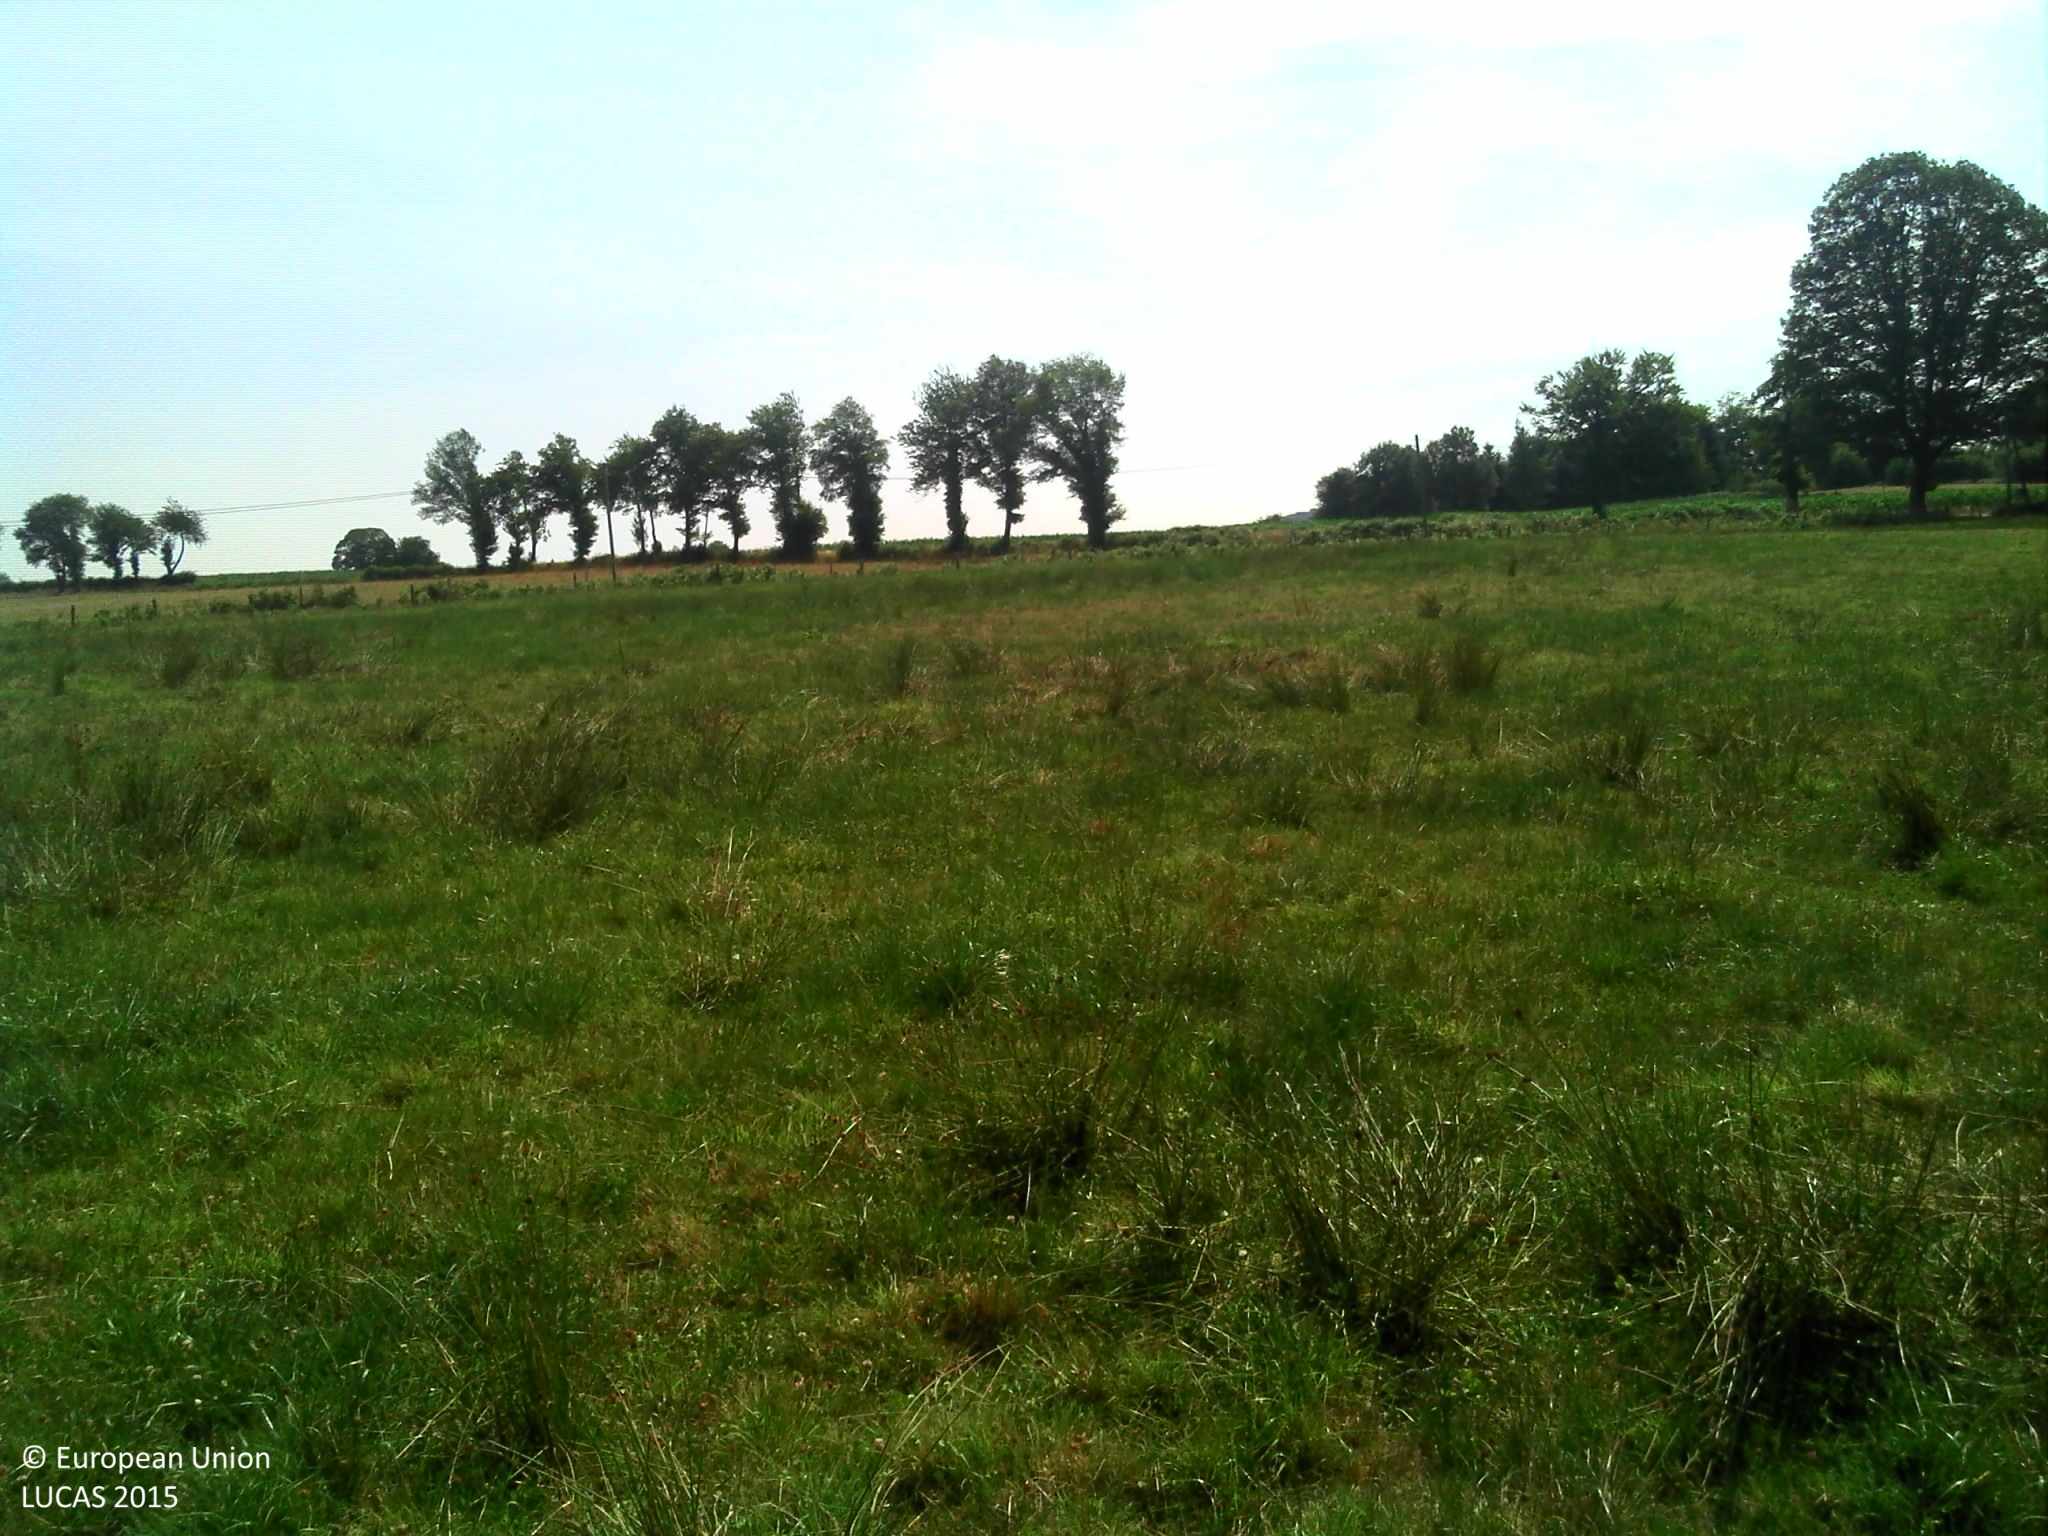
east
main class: Grassland
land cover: Grassland without tree/shrub cover
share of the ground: > 75 %
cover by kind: herbaceous plants 95 %, shrubs 5 %
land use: Agriculture (excluding fallow land and kitchen gardens)
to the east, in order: Grassland without tree/shrub cover; Fences; Electric lines; Grass margins; Paved roads, cycling and walking lanes; Grass margins; Ditches and canals; Fences; Grassland without tree/shrub cover; Fences; Lines of trees; Ditches and canals; Grass margins; Paved roads, cycling and walking lanes; Grass margins; Ditches and canals; Fences; Maize
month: July
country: FR
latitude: 46.0470
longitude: 1.7087
